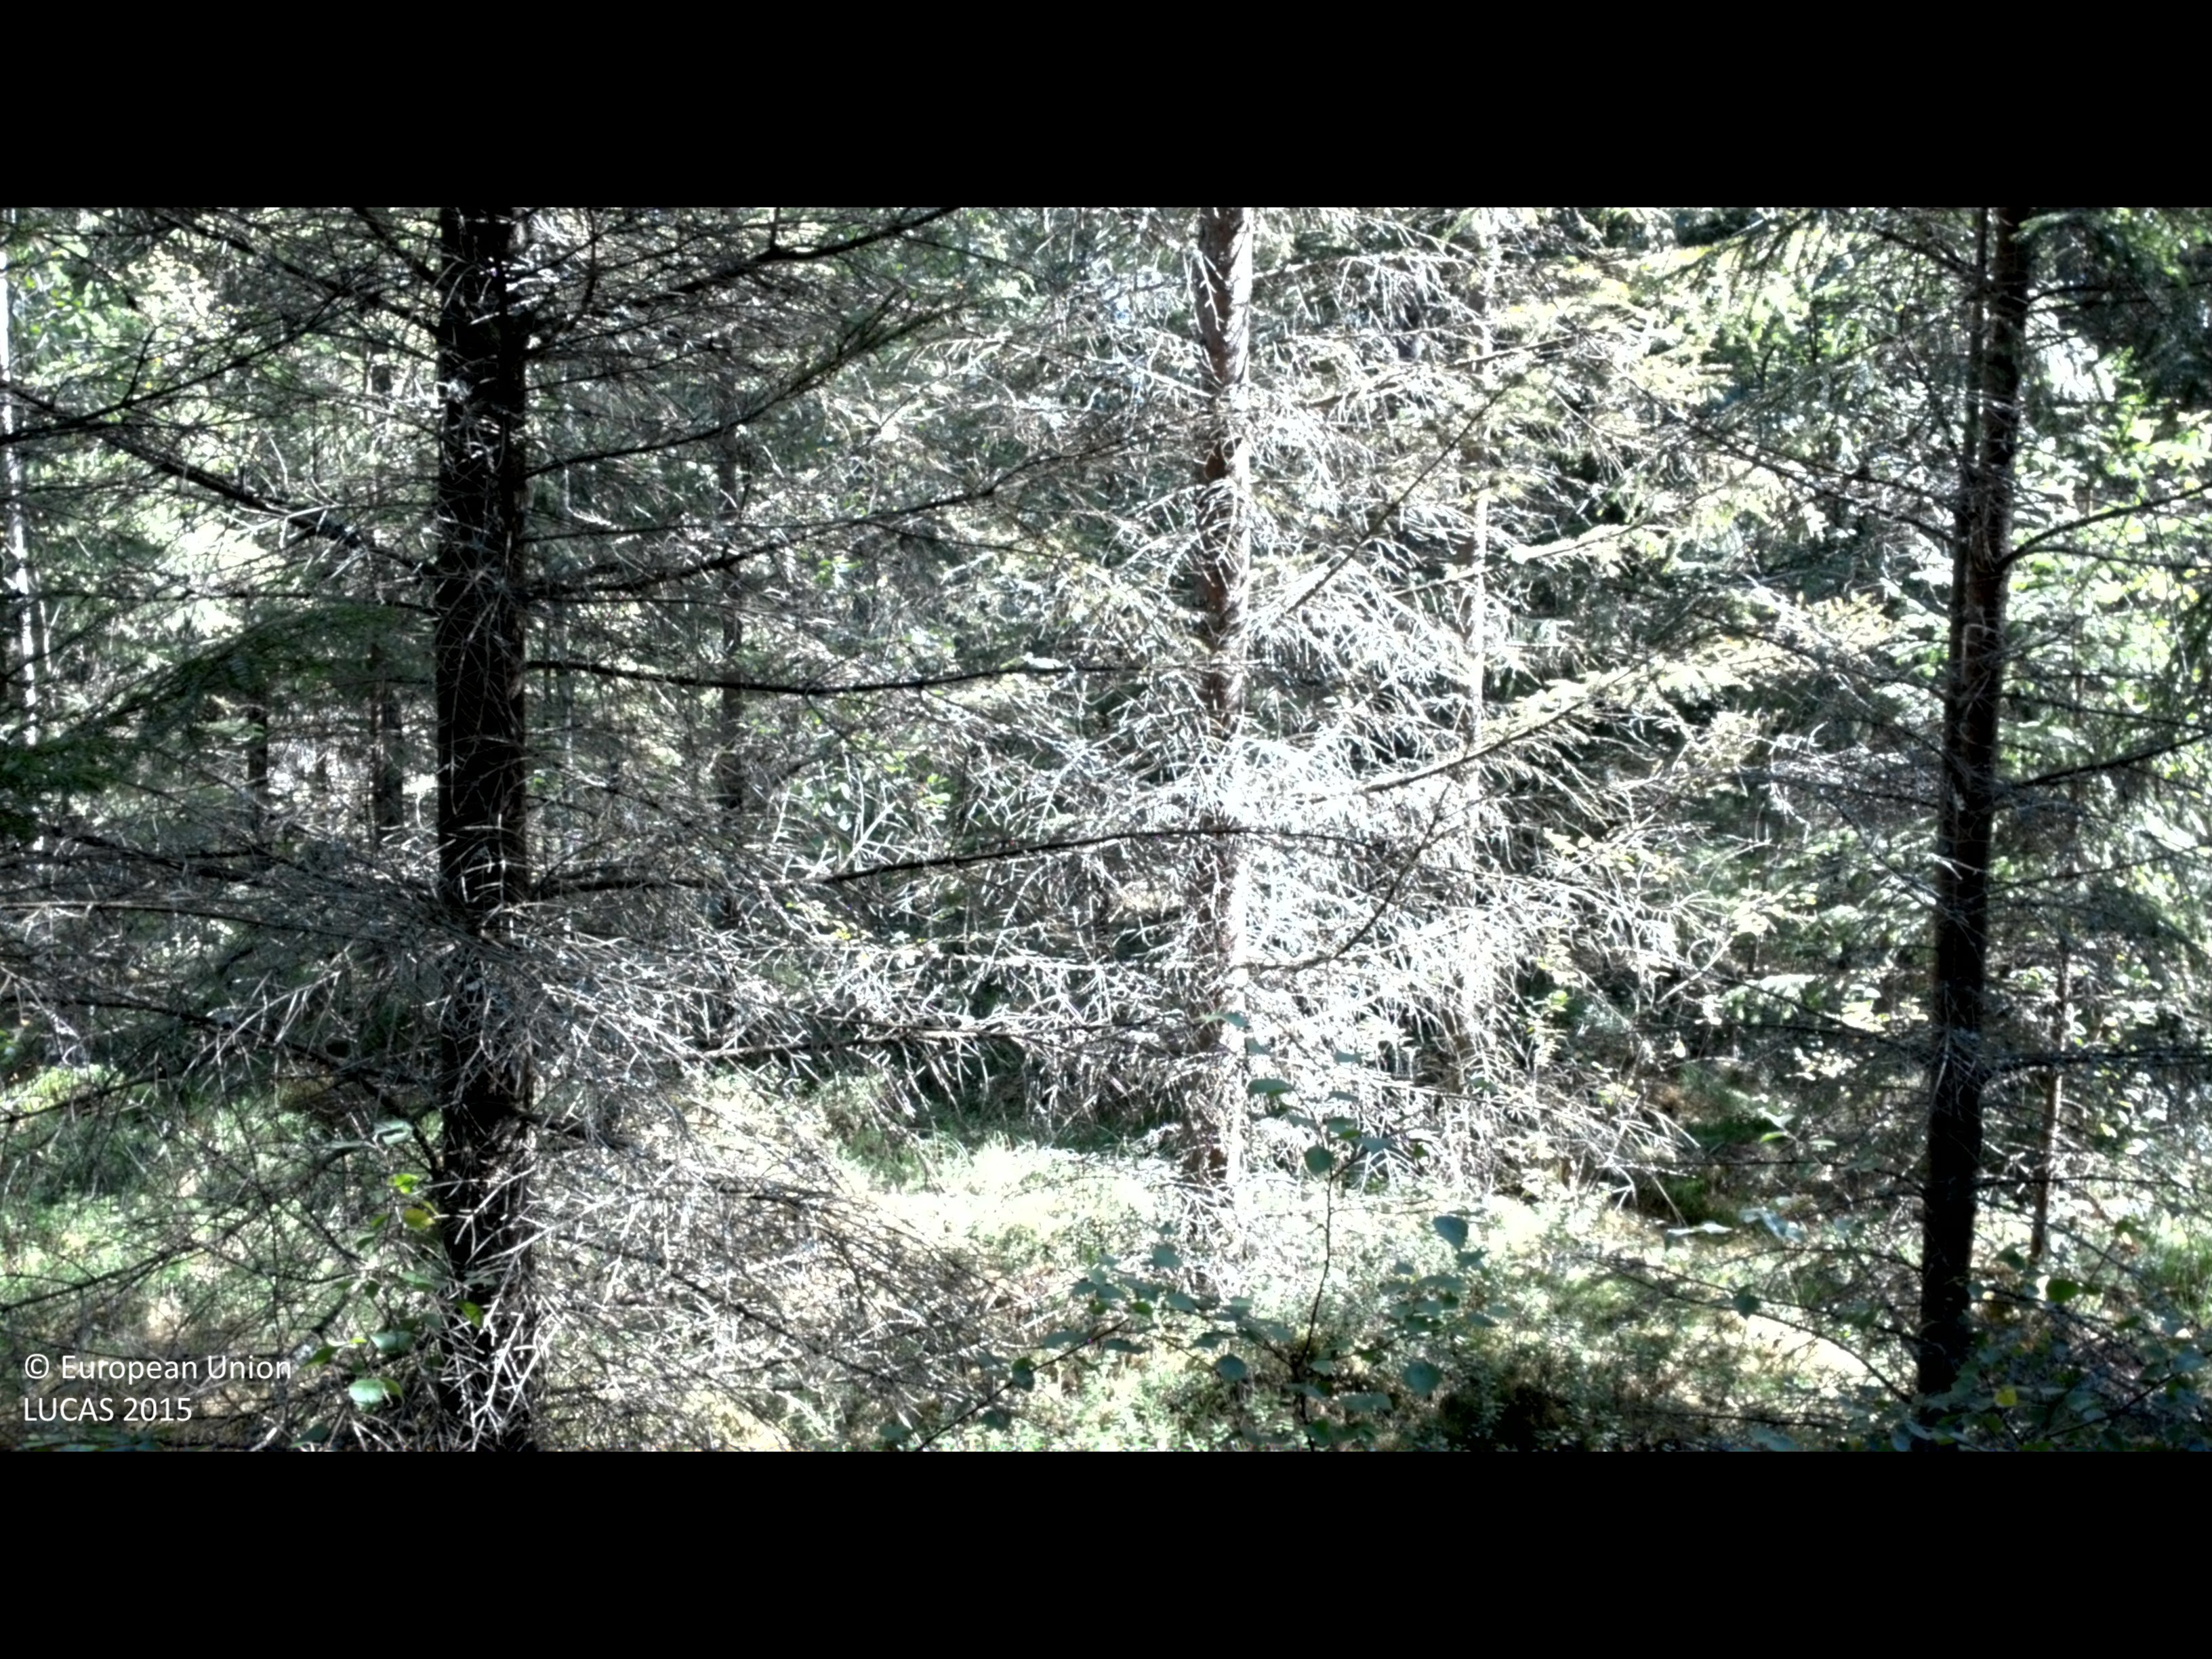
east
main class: Woodland
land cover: Spruce dominated coniferous woodland
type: boreal forest
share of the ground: > 75 %
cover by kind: coniferous forest trees 60 %, broadleaved forest trees 15 %, shrubs 15 %, herbaceous plants 5 %, lichens and mosses 5 %
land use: Forestry
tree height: > 5 m
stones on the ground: 10 - 25 %
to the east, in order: Spruce dominated coniferous woodland; Spruce dominated mixed woodland; Pine dominated mixed woodland; Spruce dominated mixed woodland; Spontaneously vegetated surfaces
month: August
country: SE
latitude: 56.9757
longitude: 13.8626
